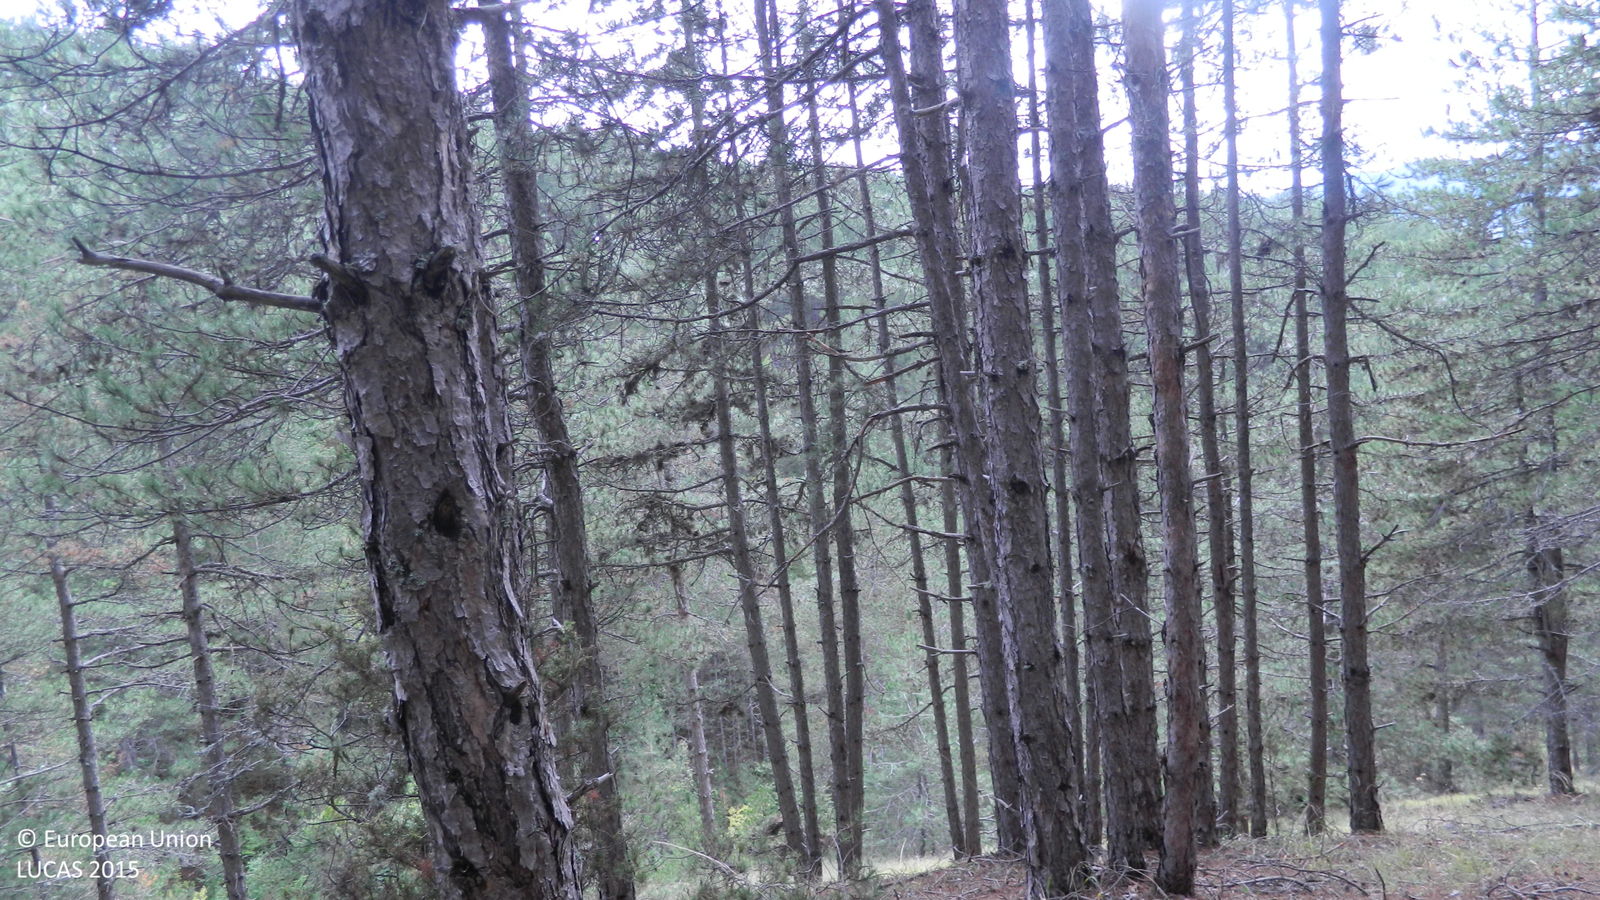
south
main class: Woodland
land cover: Pine dominated coniferous woodland
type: hemiboreal forest and nemoral coniferous forest and mixed broadleaved-coniferous forest
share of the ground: > 75 %
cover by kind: coniferous forest trees 80 %, unconsolidated bare surface 20 %
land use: Forestry
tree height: > 5 m
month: September
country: BG
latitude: 41.4885
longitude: 24.0333
